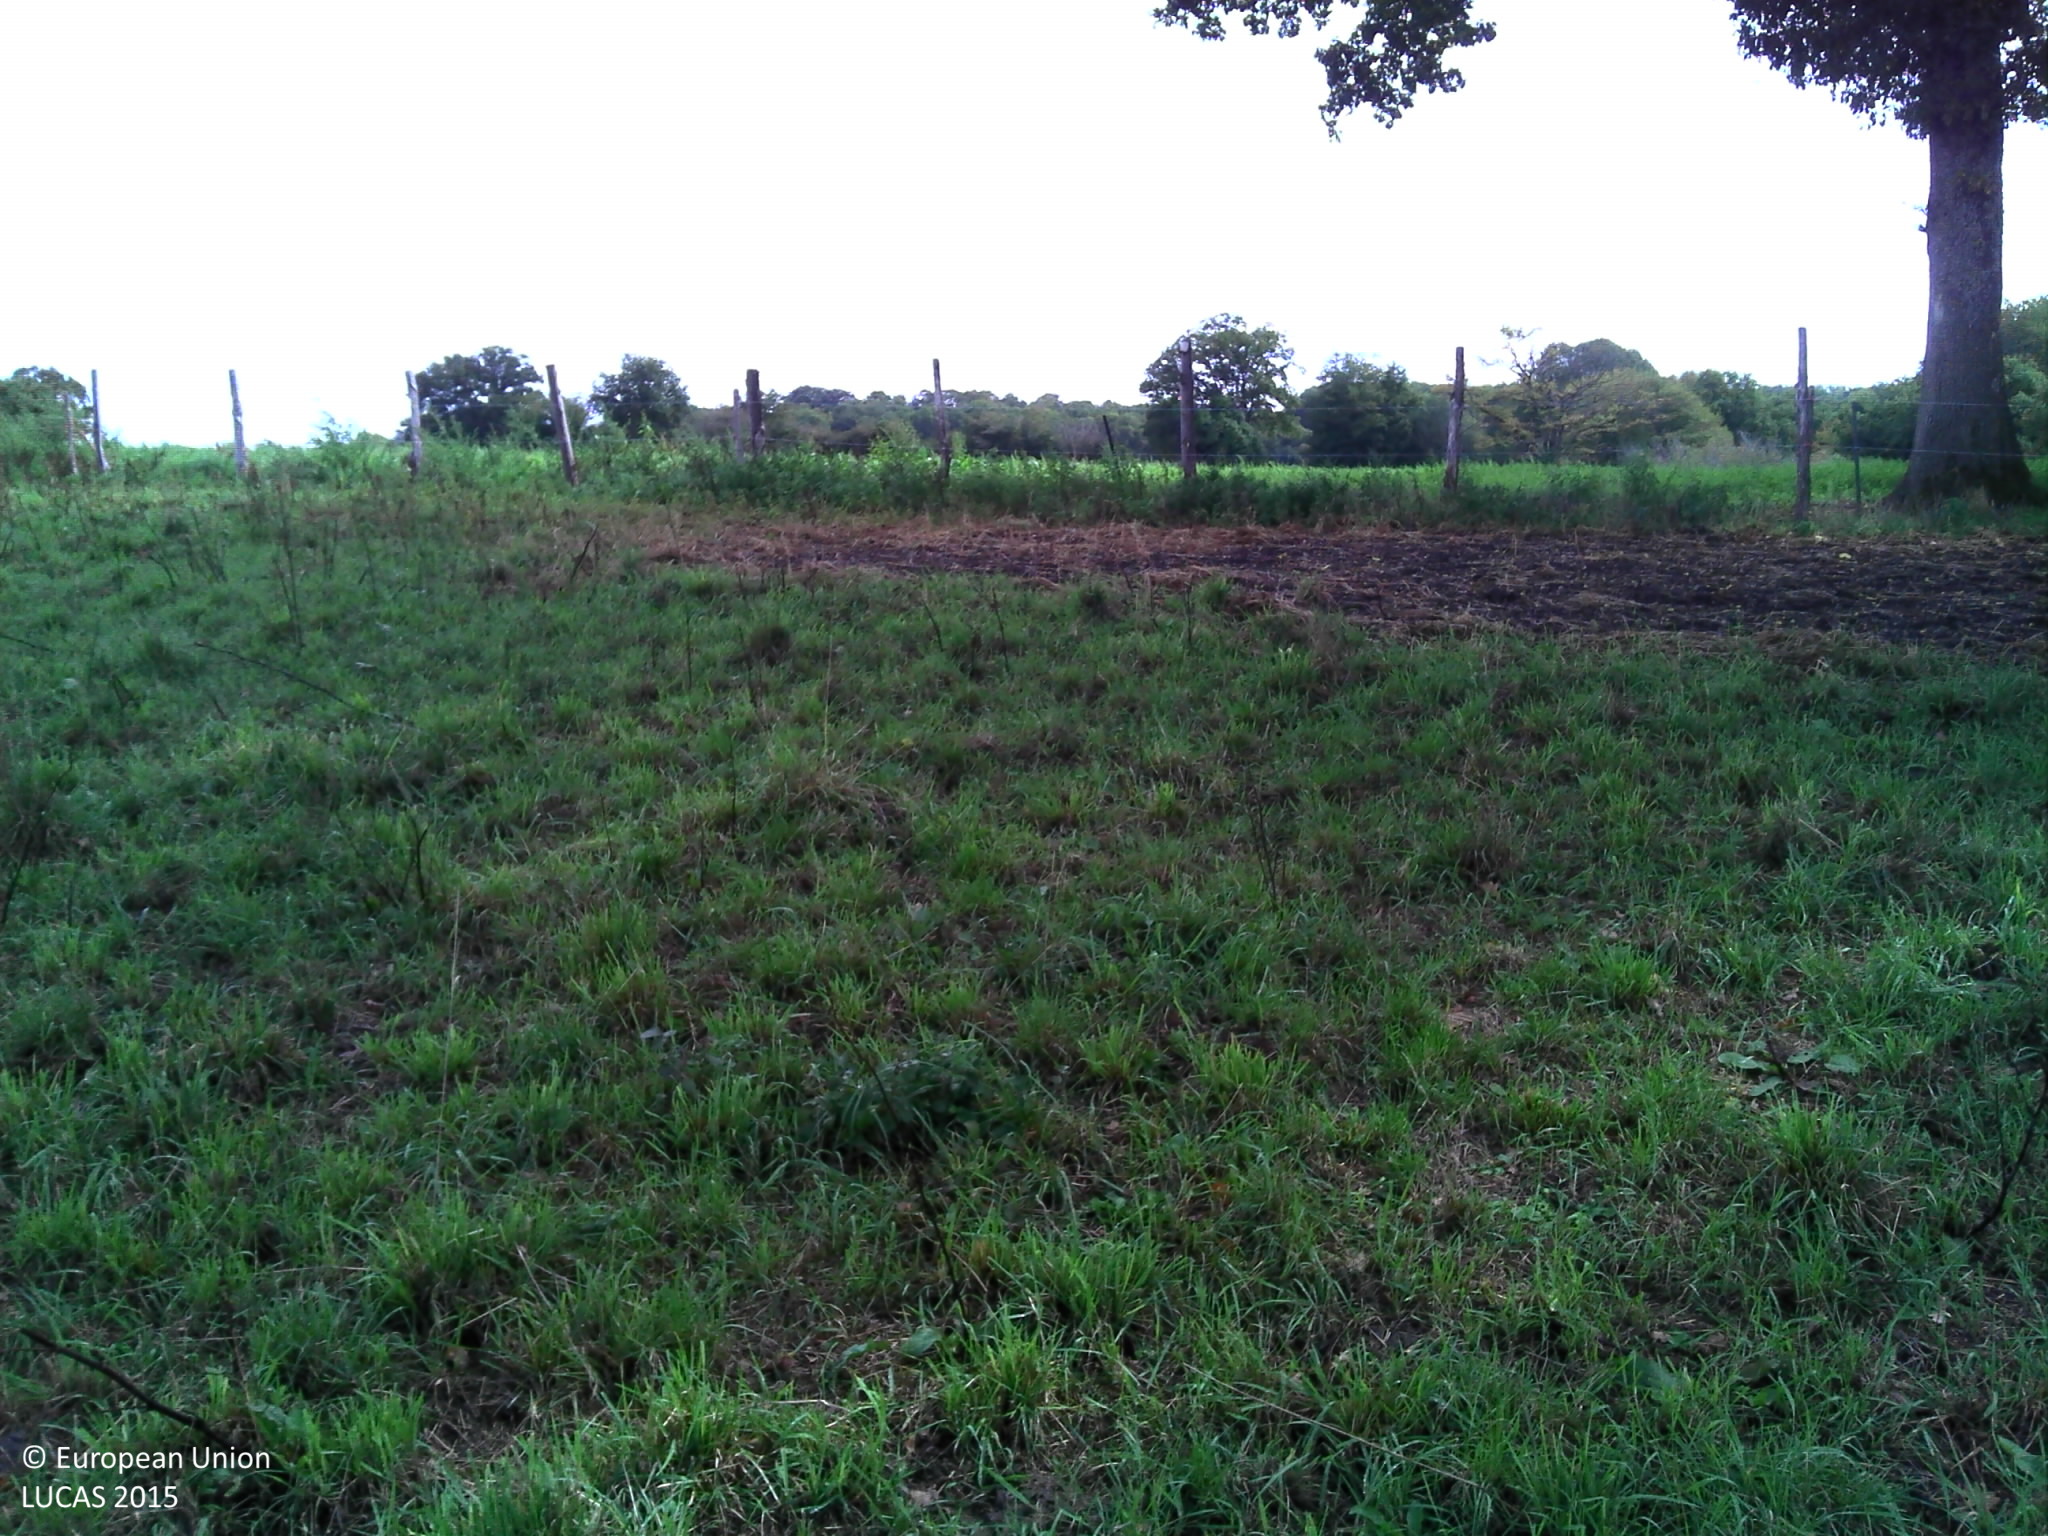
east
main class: Grassland
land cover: Grassland without tree/shrub cover
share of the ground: > 75 %
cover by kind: herbaceous plants 100 %
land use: Agriculture (excluding fallow land and kitchen gardens)
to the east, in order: Grassland without tree/shrub cover; Fences; Grassland without tree/shrub cover; Fences; Managed hedges; Grassland without tree/shrub cover; Abandoned hedges; Single bushes/trees; Grassland without tree/shrub cover
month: September
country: FR
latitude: 46.4445
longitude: 1.6993
